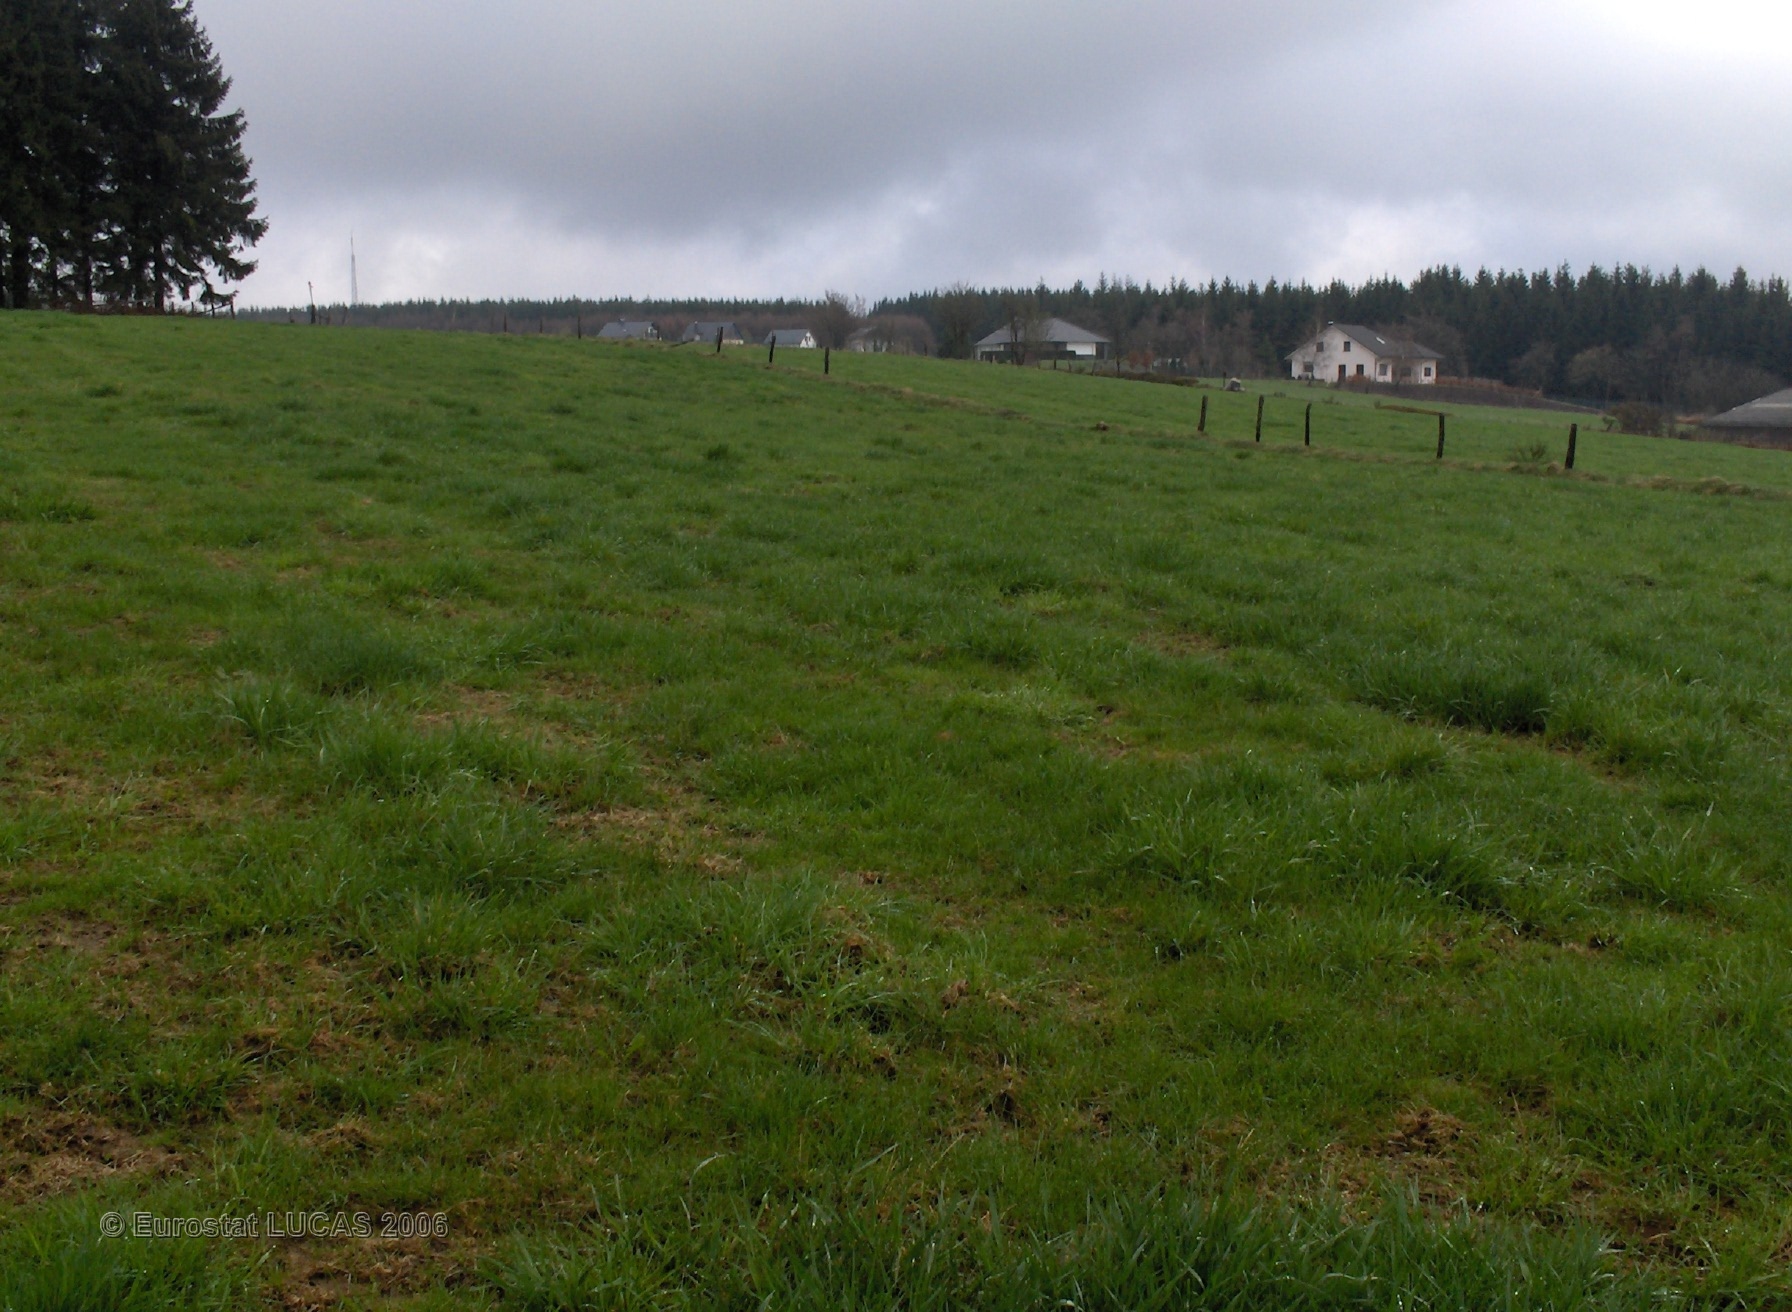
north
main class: Grassland
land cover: Grassland without tree/shrub cover
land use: Agriculture (excluding fallow land and kitchen gardens)
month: May
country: BE
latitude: 50.3592
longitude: 6.3307
